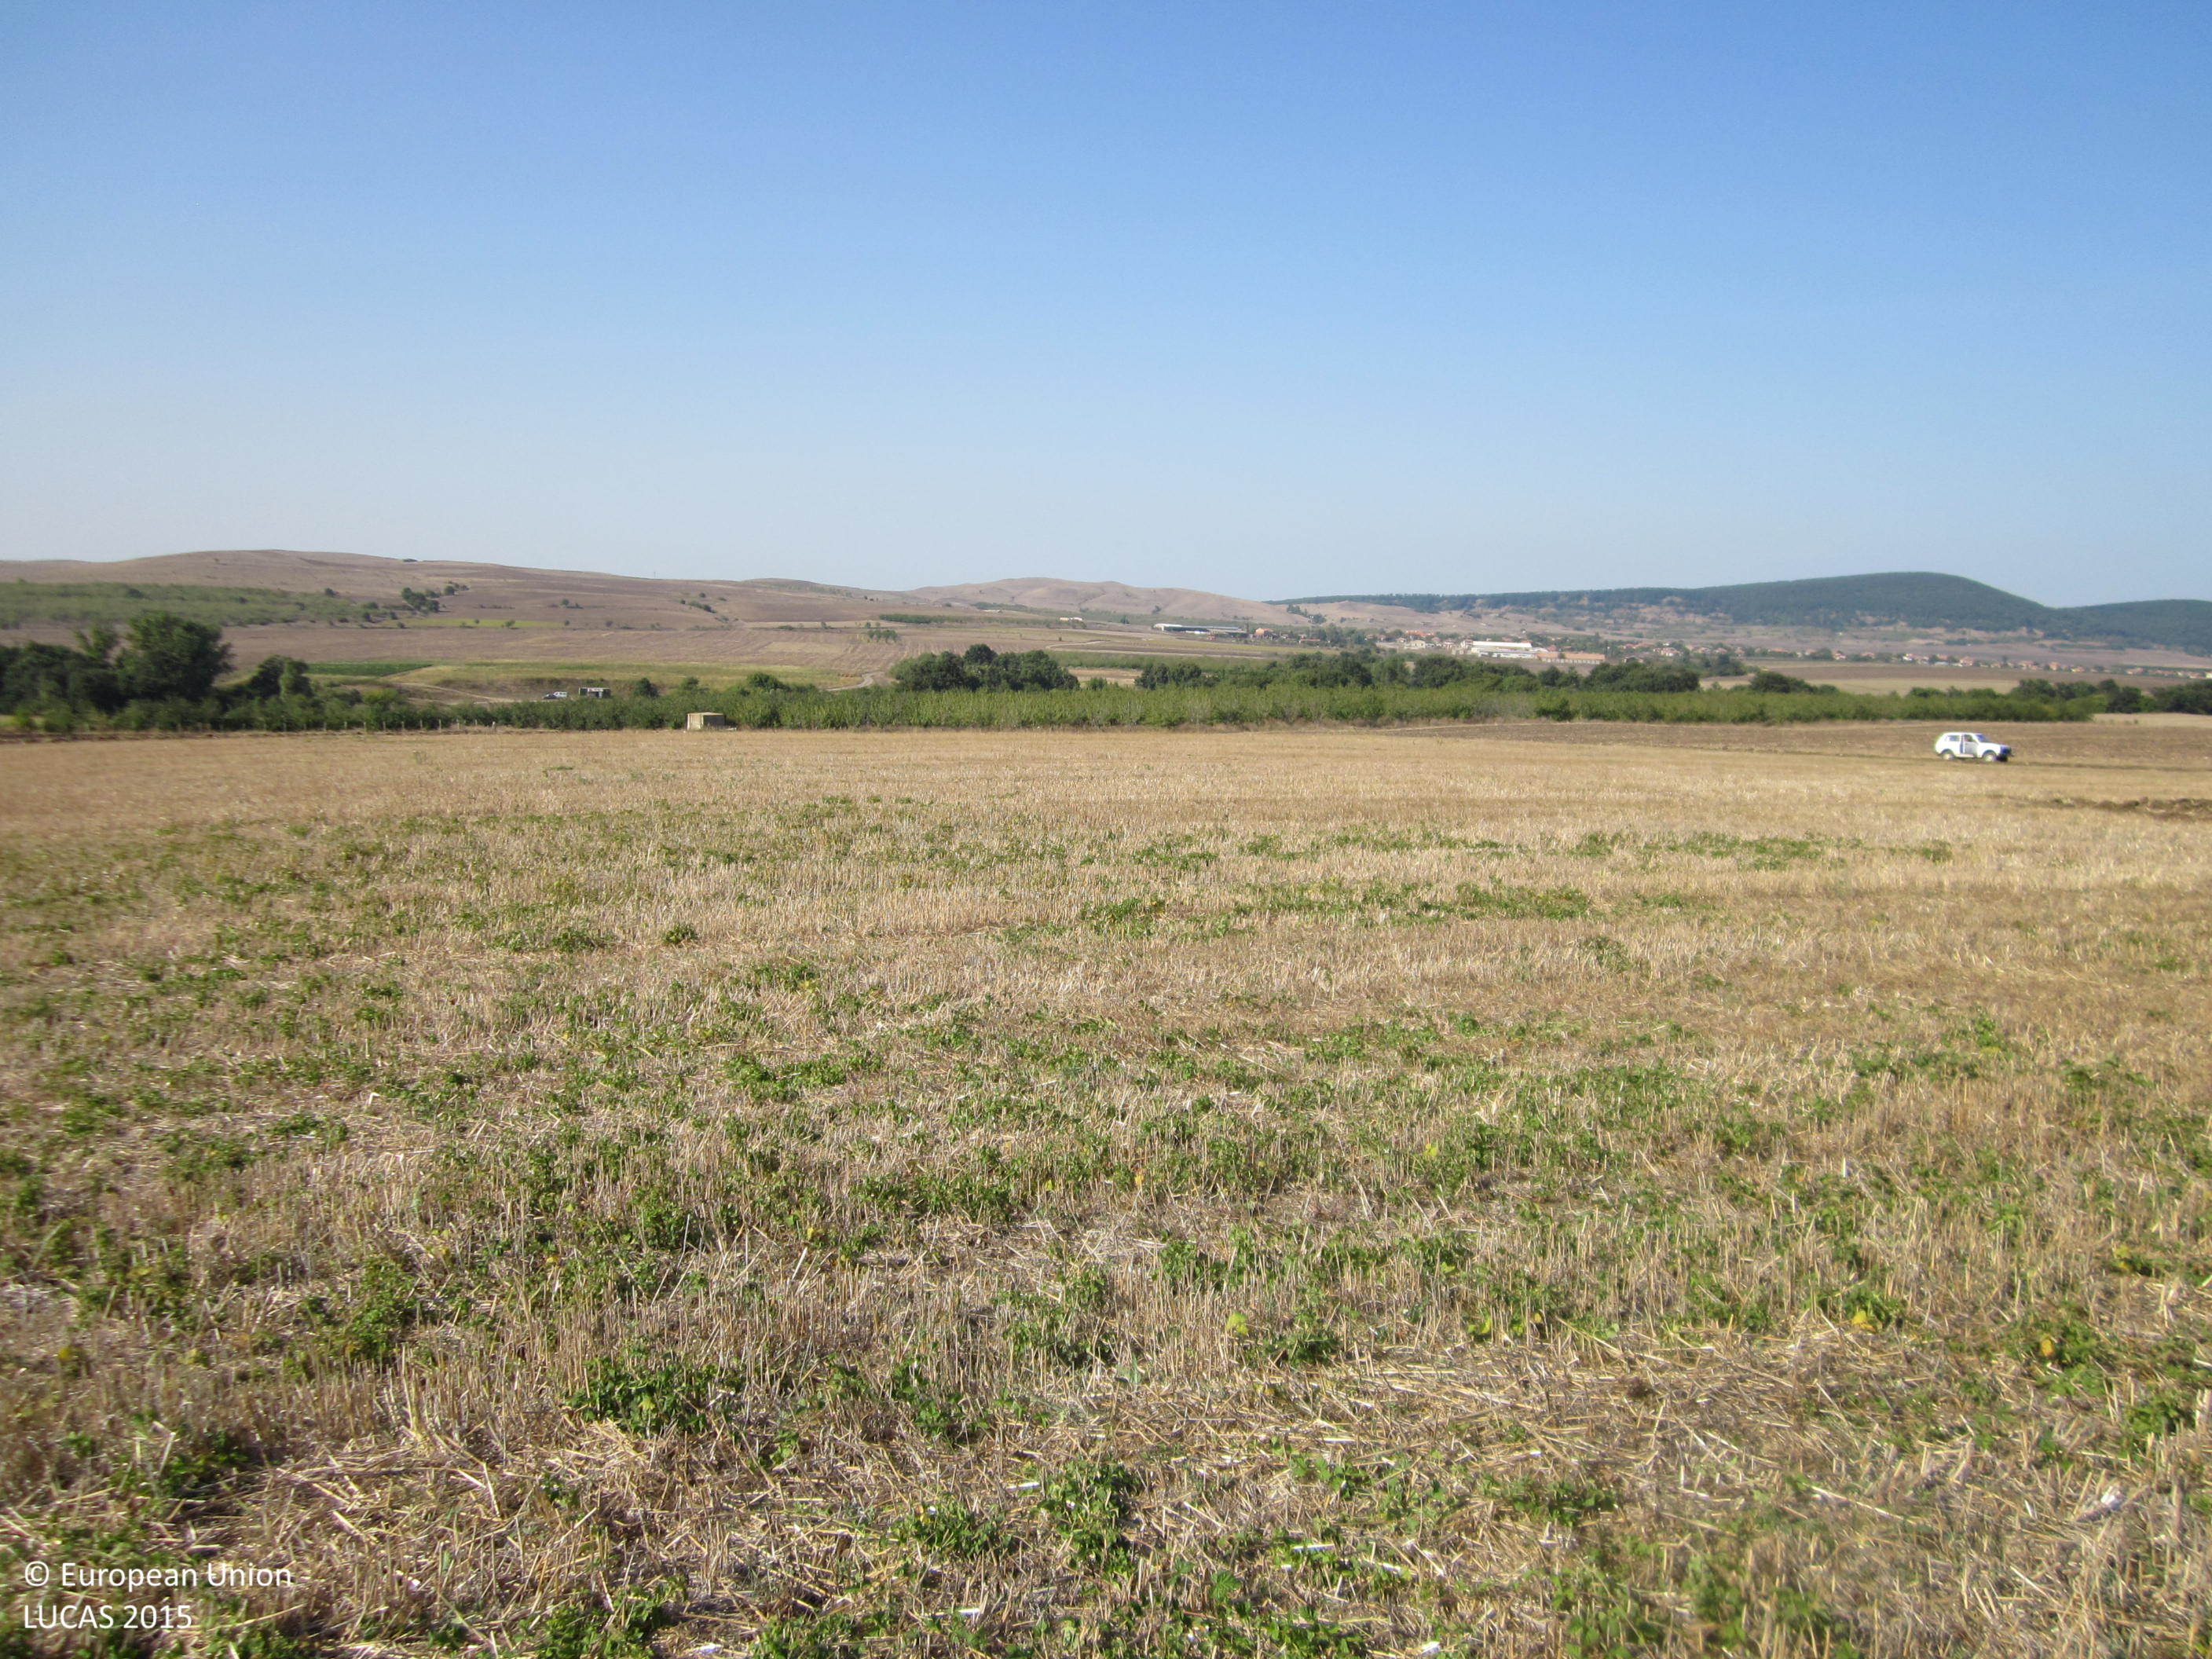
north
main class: Cropland
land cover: Common wheat
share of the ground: 25 - 50 %
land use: Agriculture (excluding fallow land and kitchen gardens)
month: September
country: BG
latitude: 42.7063
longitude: 27.3680
